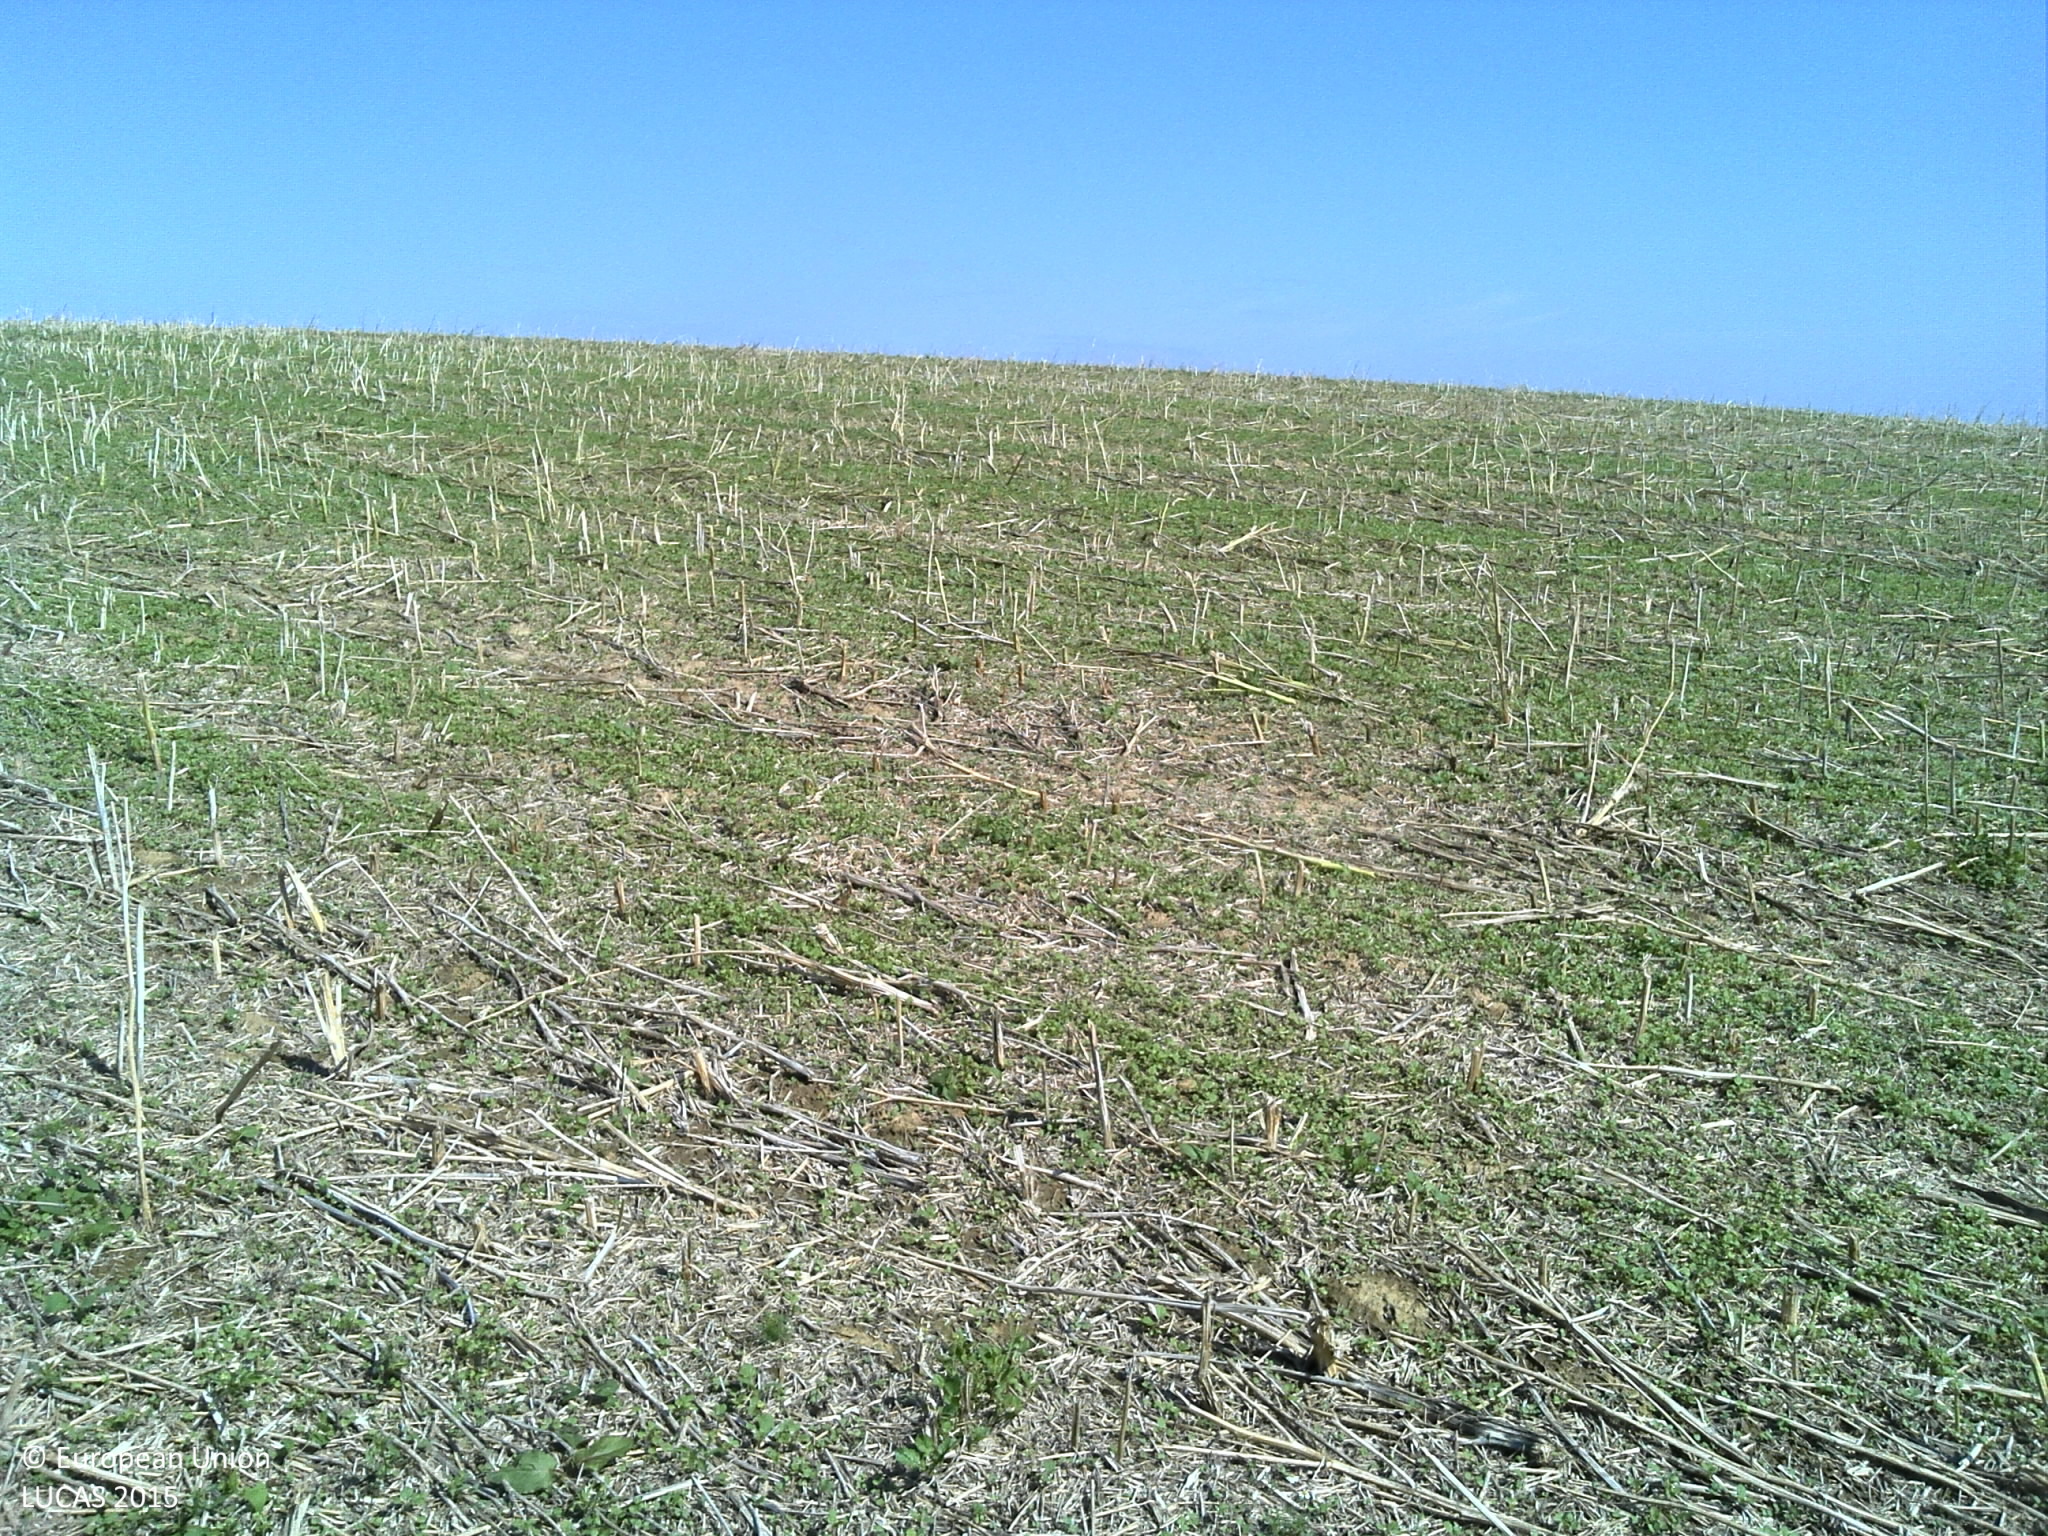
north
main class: Cropland
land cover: Rape and turnip rape
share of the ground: 10 - 25 %
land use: Agriculture (excluding fallow land and kitchen gardens)
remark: Harvested field
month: August
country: FR
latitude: 50.0136
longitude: 3.1390
